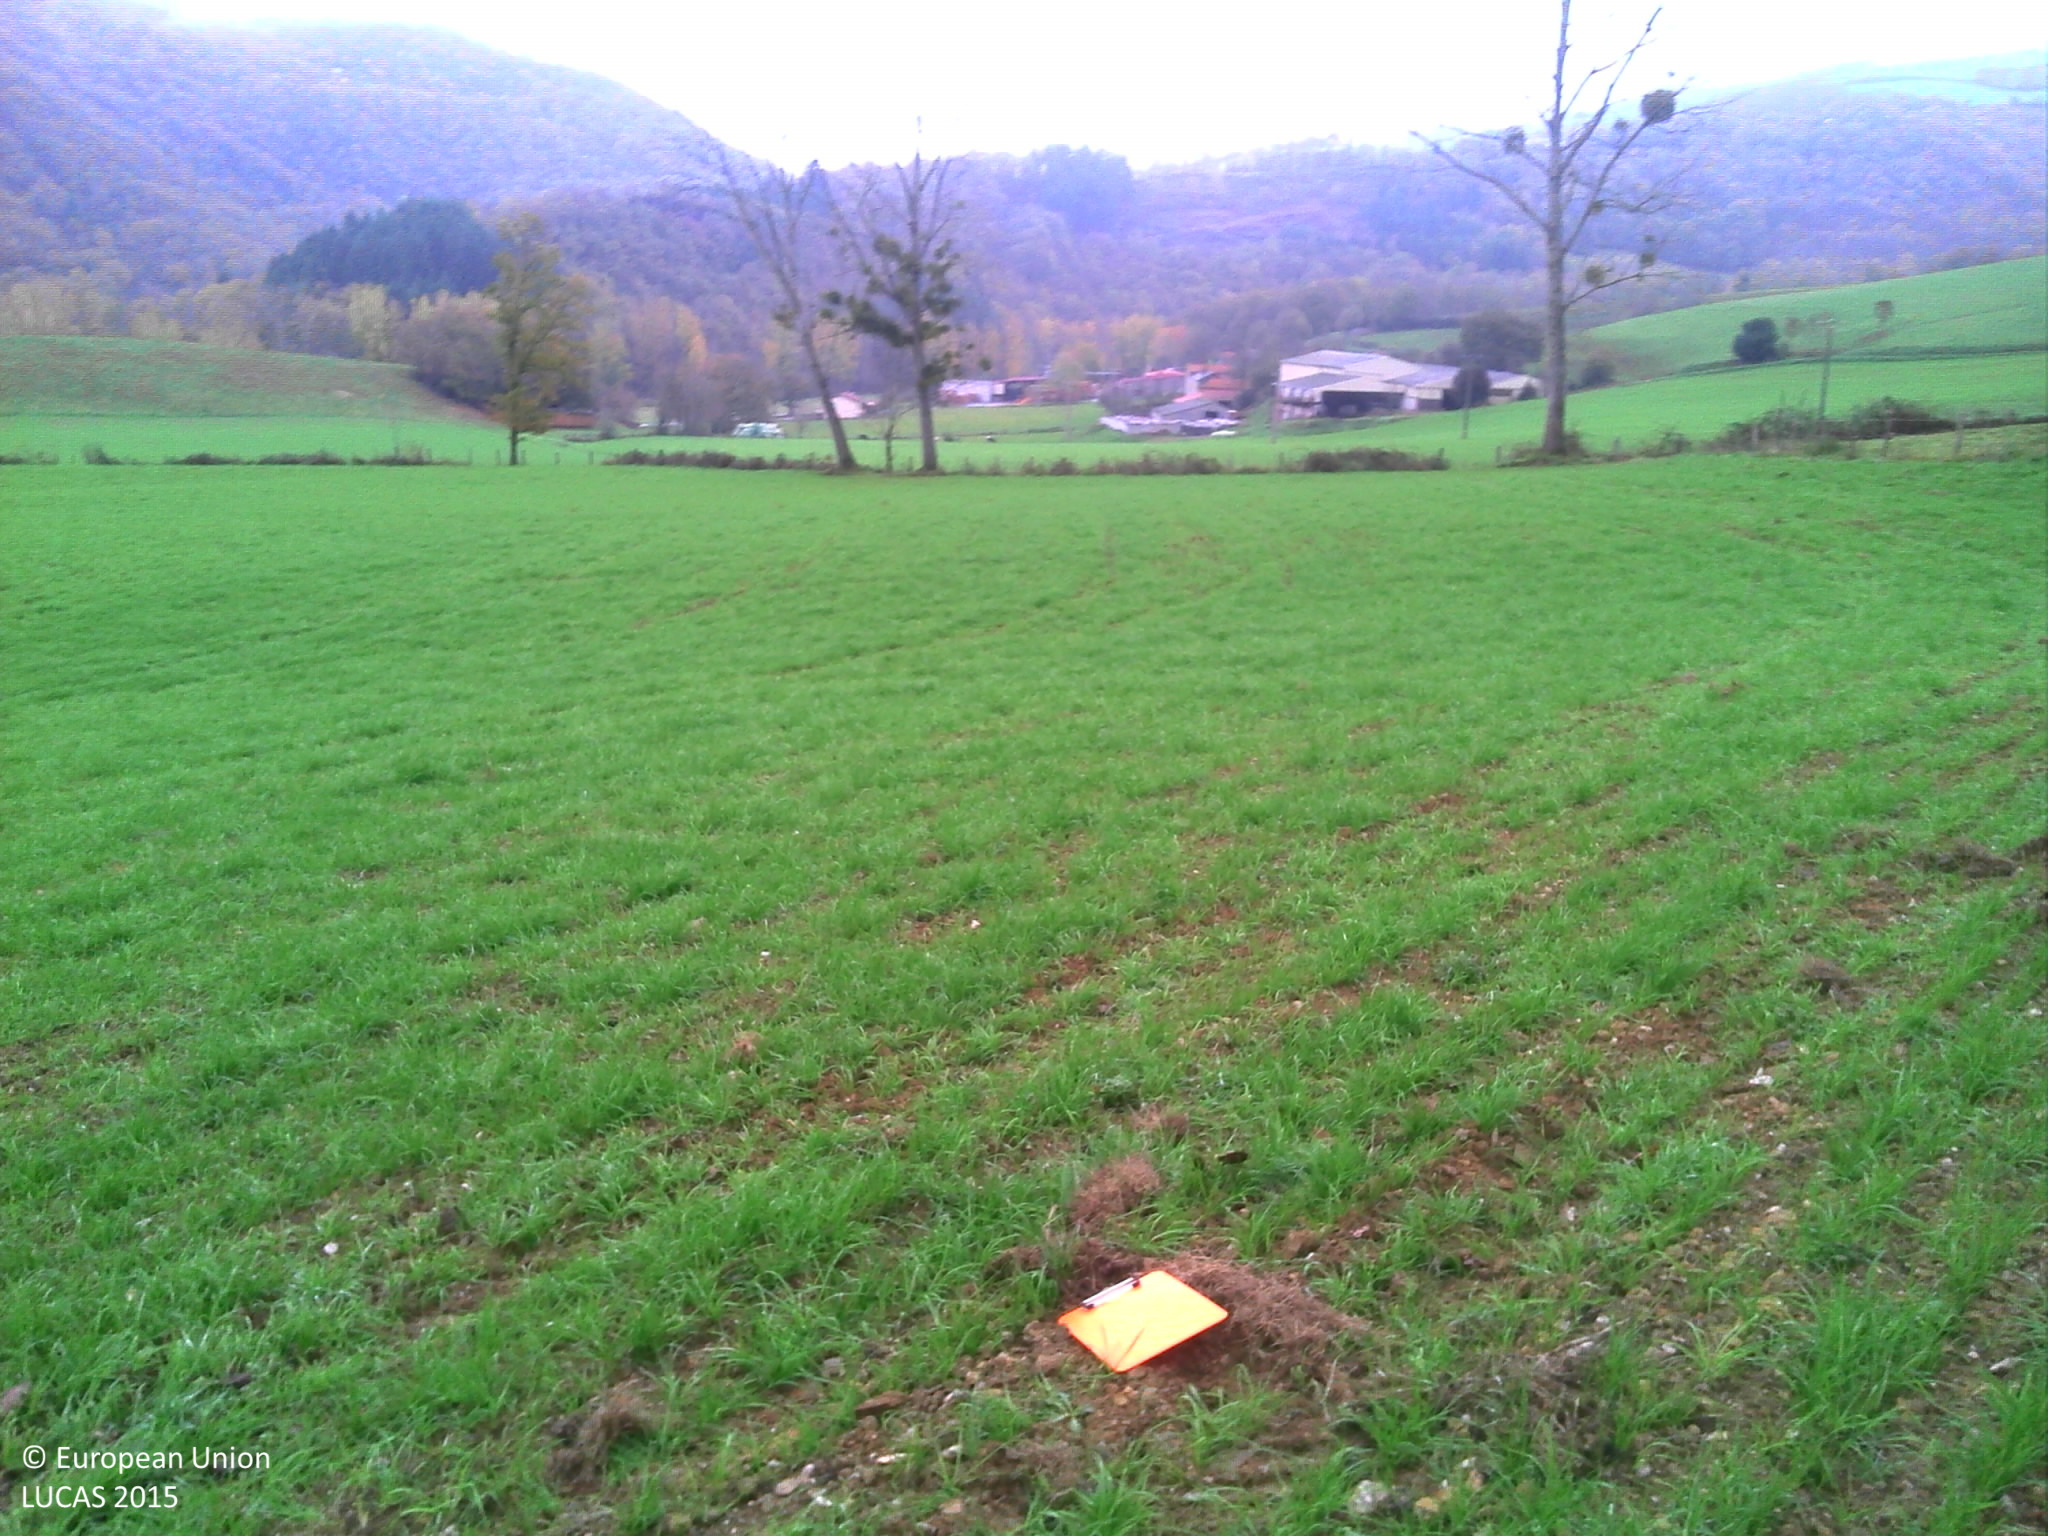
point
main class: Cropland
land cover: Temporary grasslands
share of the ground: > 75 %
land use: Agriculture (excluding fallow land and kitchen gardens)
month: November
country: FR
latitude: 43.9192
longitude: 2.5453
